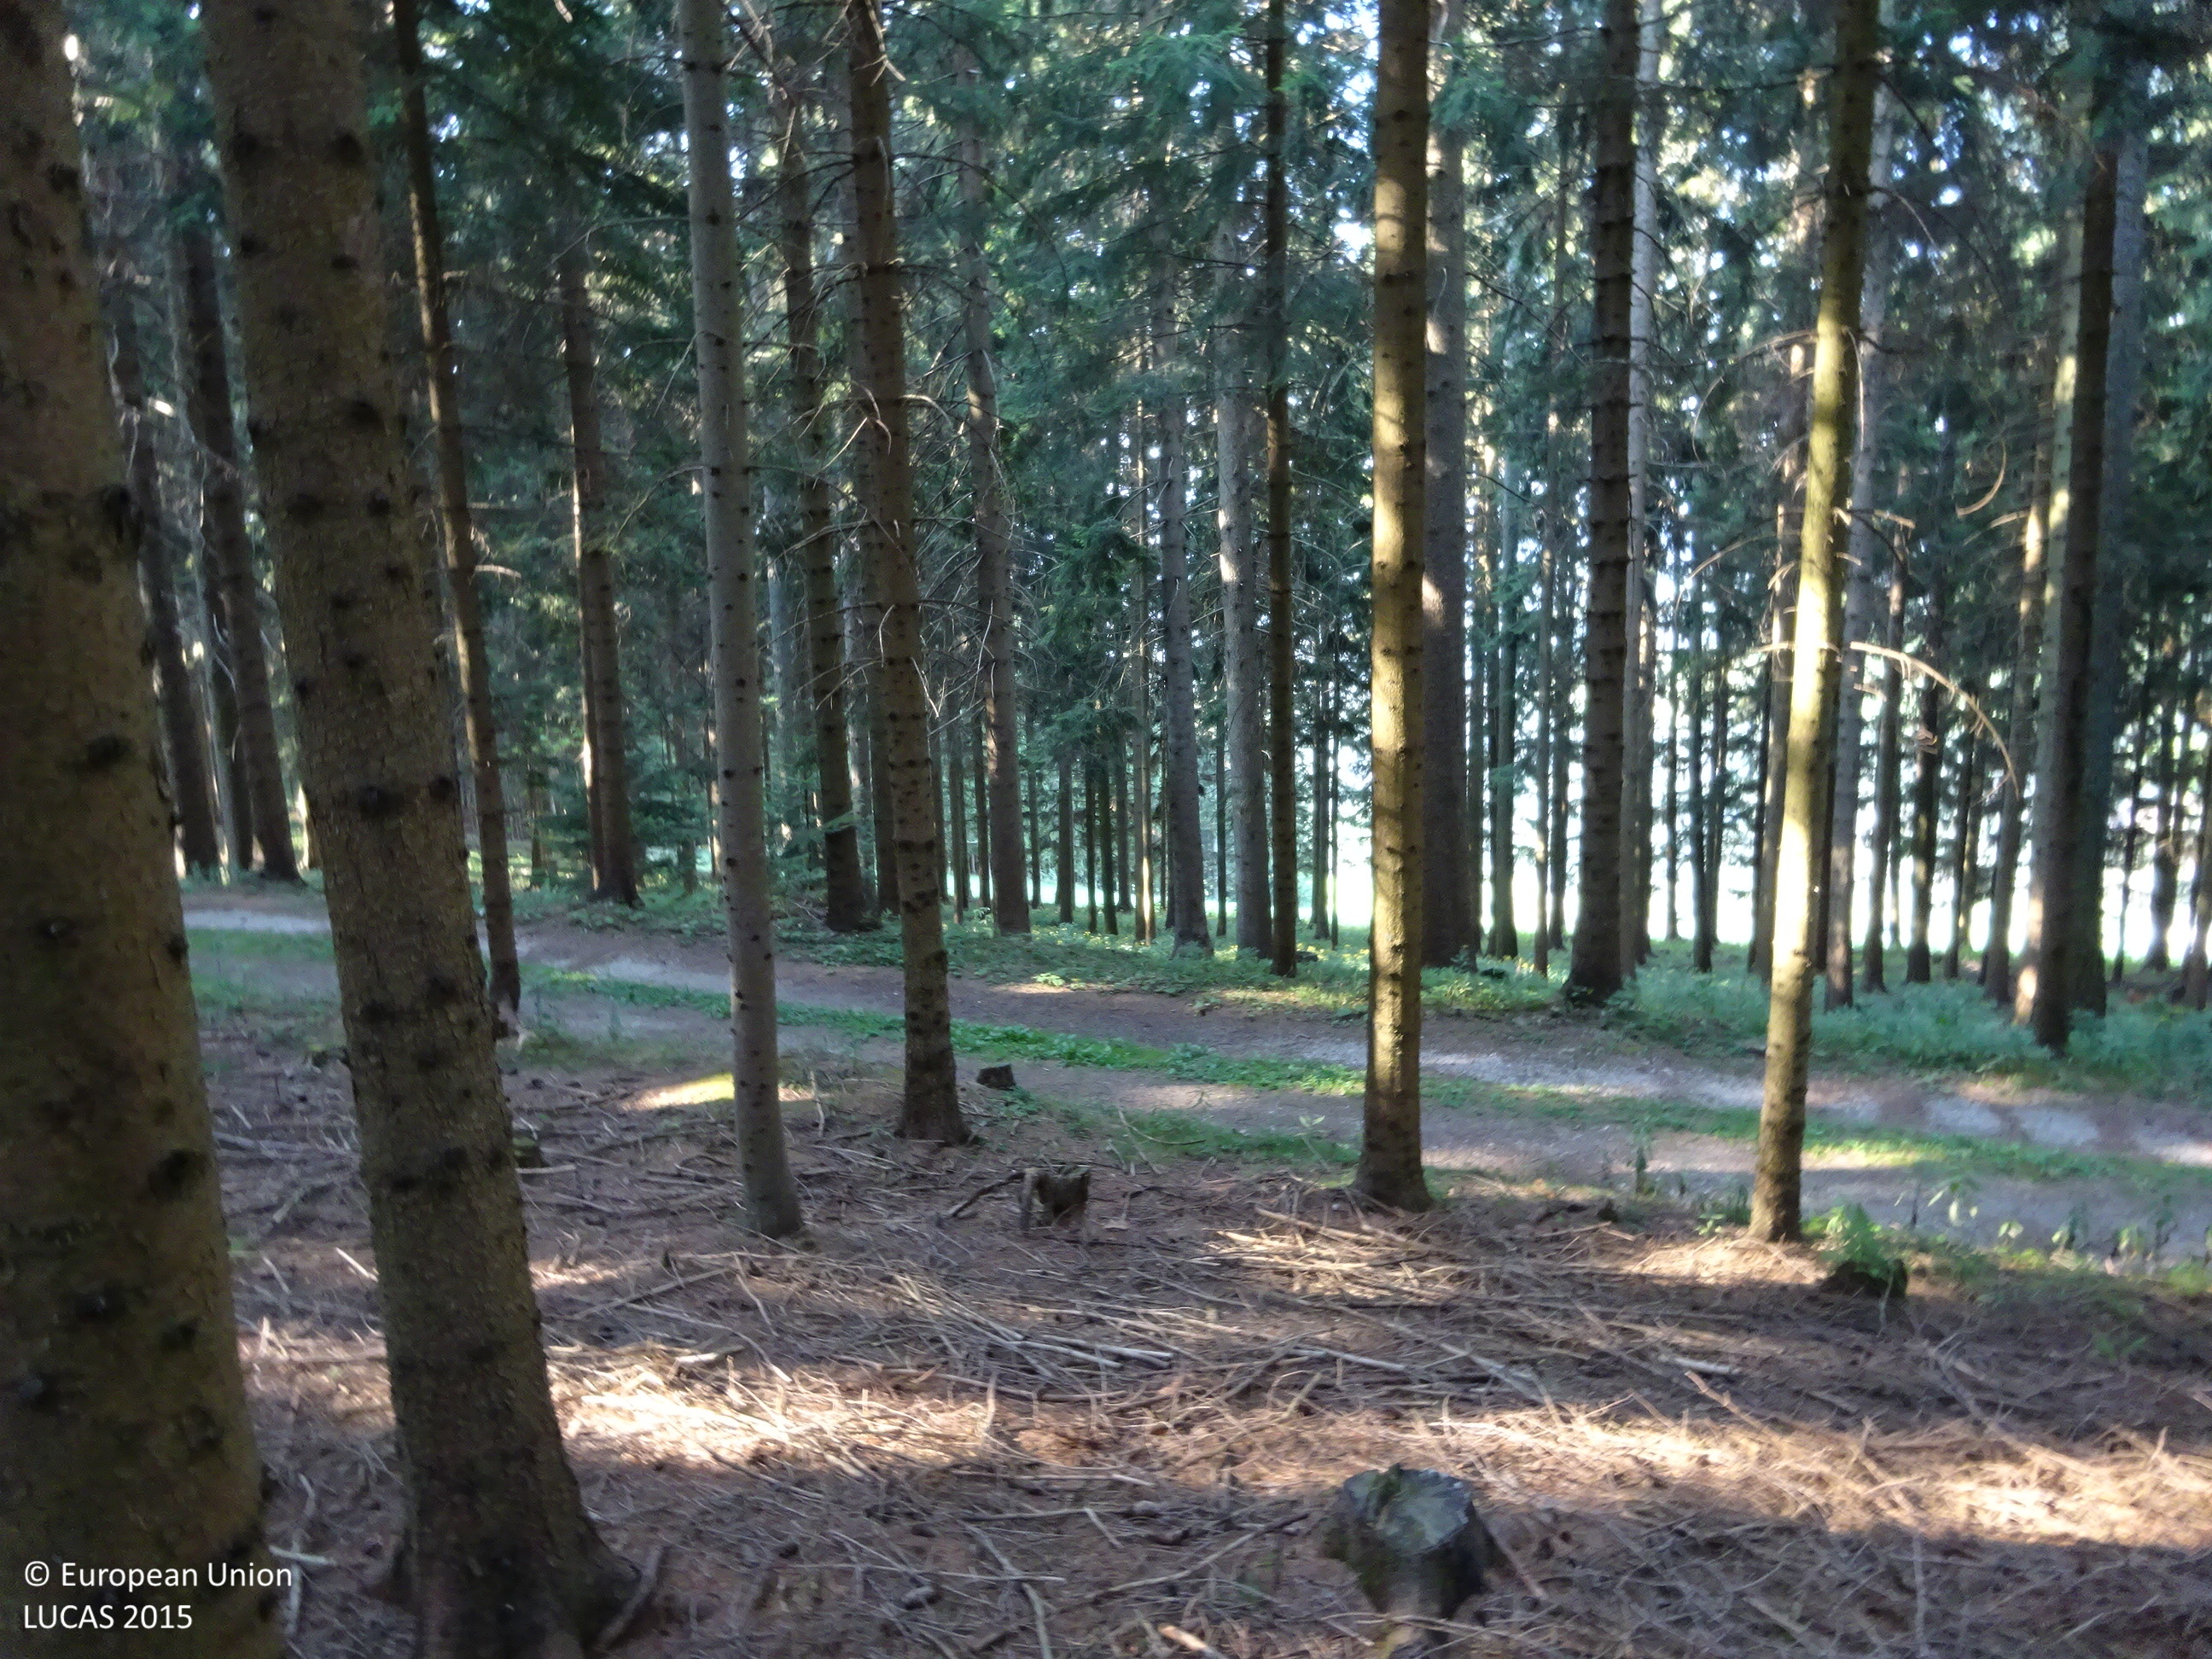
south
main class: Woodland
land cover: Spruce dominated coniferous woodland
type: alpine coniferous forest
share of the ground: > 75 %
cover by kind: coniferous forest trees 95 %, unconsolidated bare surface 5 %
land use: Forestry
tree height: > 5 m
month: August
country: AT
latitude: 47.4934
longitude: 15.8022
